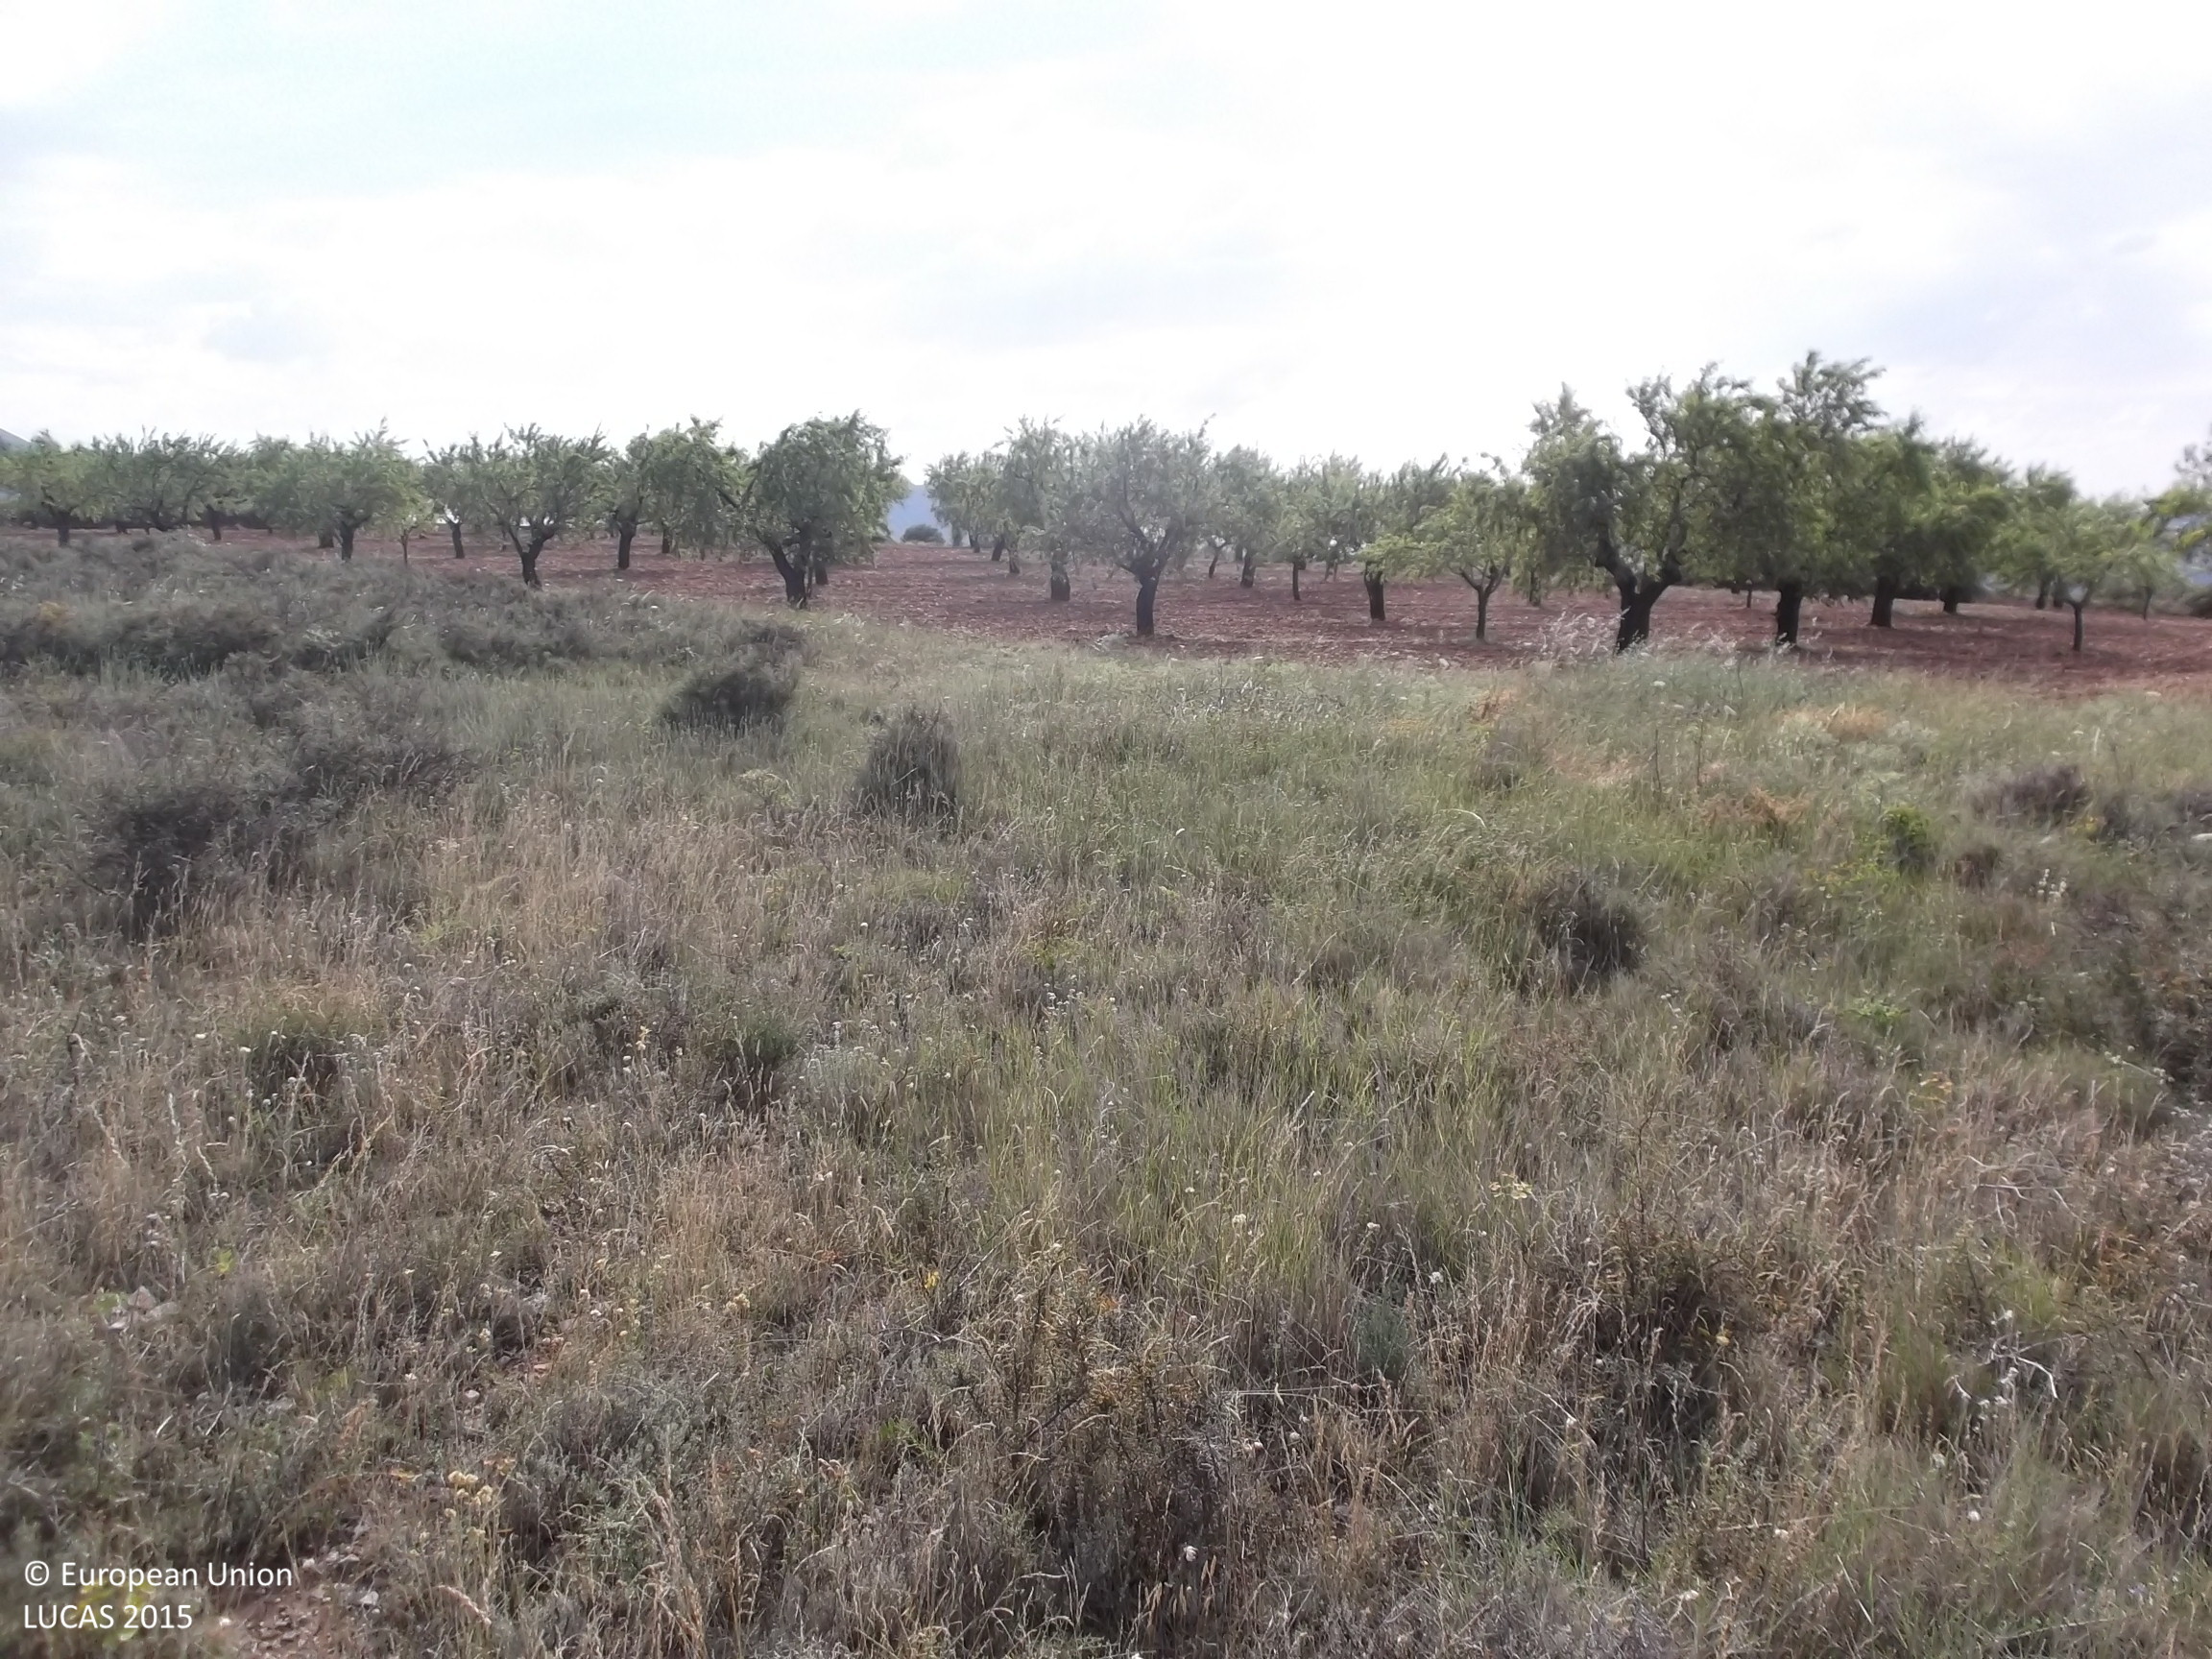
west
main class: Shrubland
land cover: Shrubland without tree cover
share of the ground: > 75 %
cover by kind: shrubs 80 %, herbaceous plants 20 %
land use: Semi-natural and natural areas not in use
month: July
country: ES
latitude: 42.1979
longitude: -2.1124
